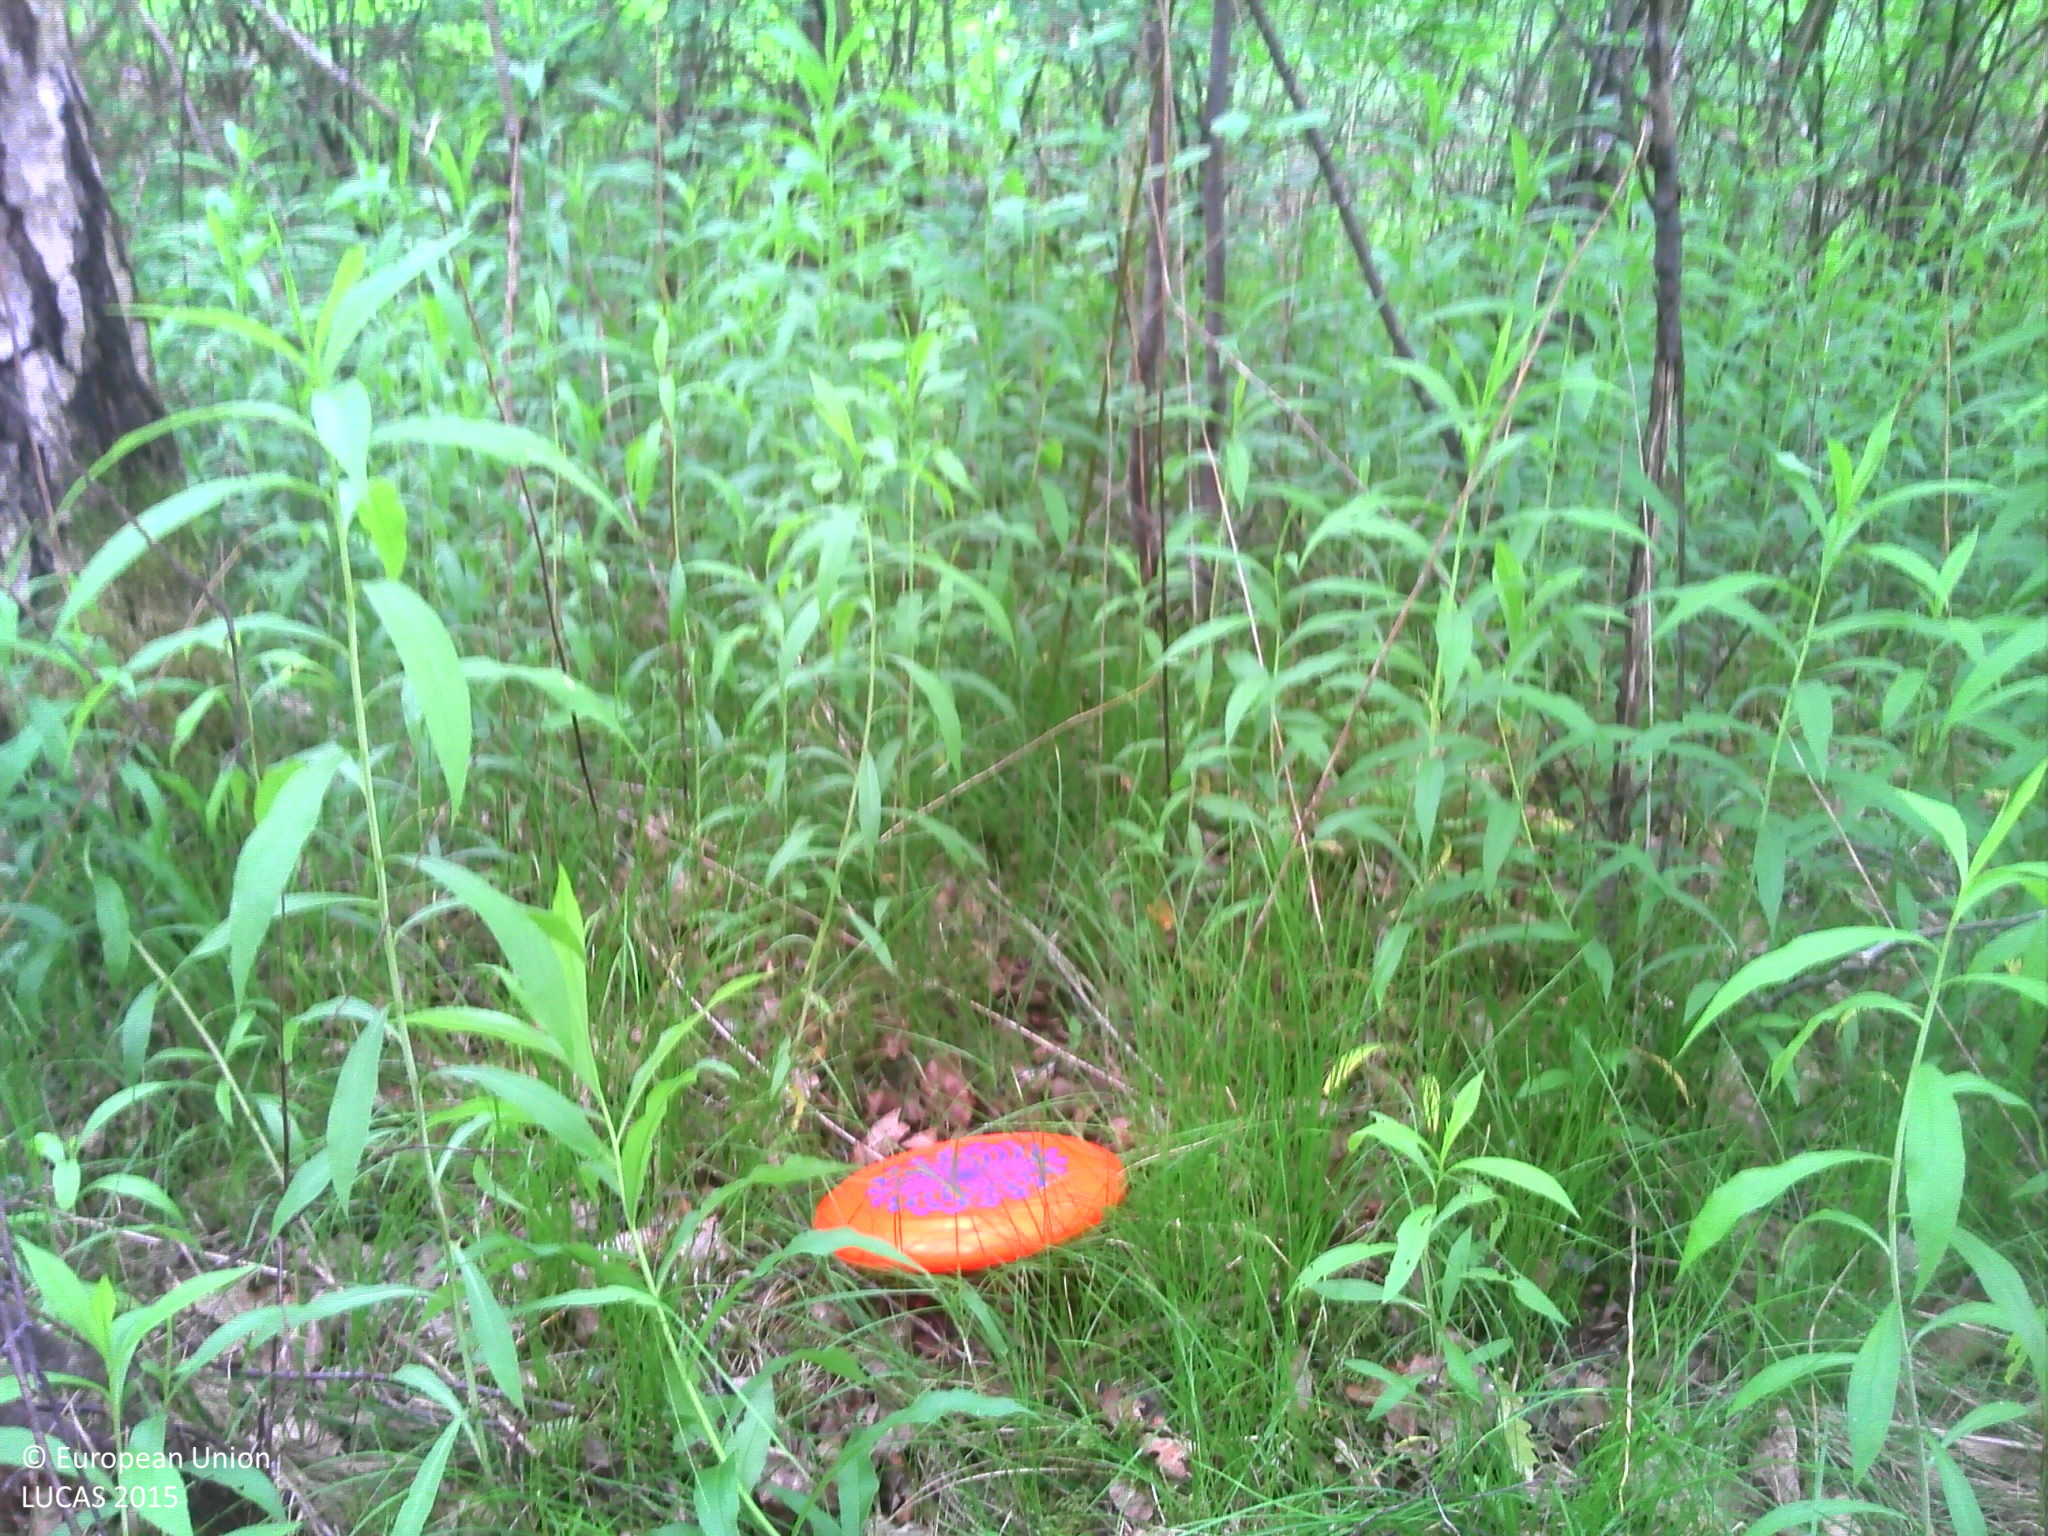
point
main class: Woodland
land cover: Broadleaved woodland
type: mesophytic deciduous forest
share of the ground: > 75 %
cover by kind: broadleaved forest trees 80 %, herbaceous plants 20 %
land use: Forestry
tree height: > 5 m
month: June
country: FR
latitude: 47.9089
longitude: 7.5797
